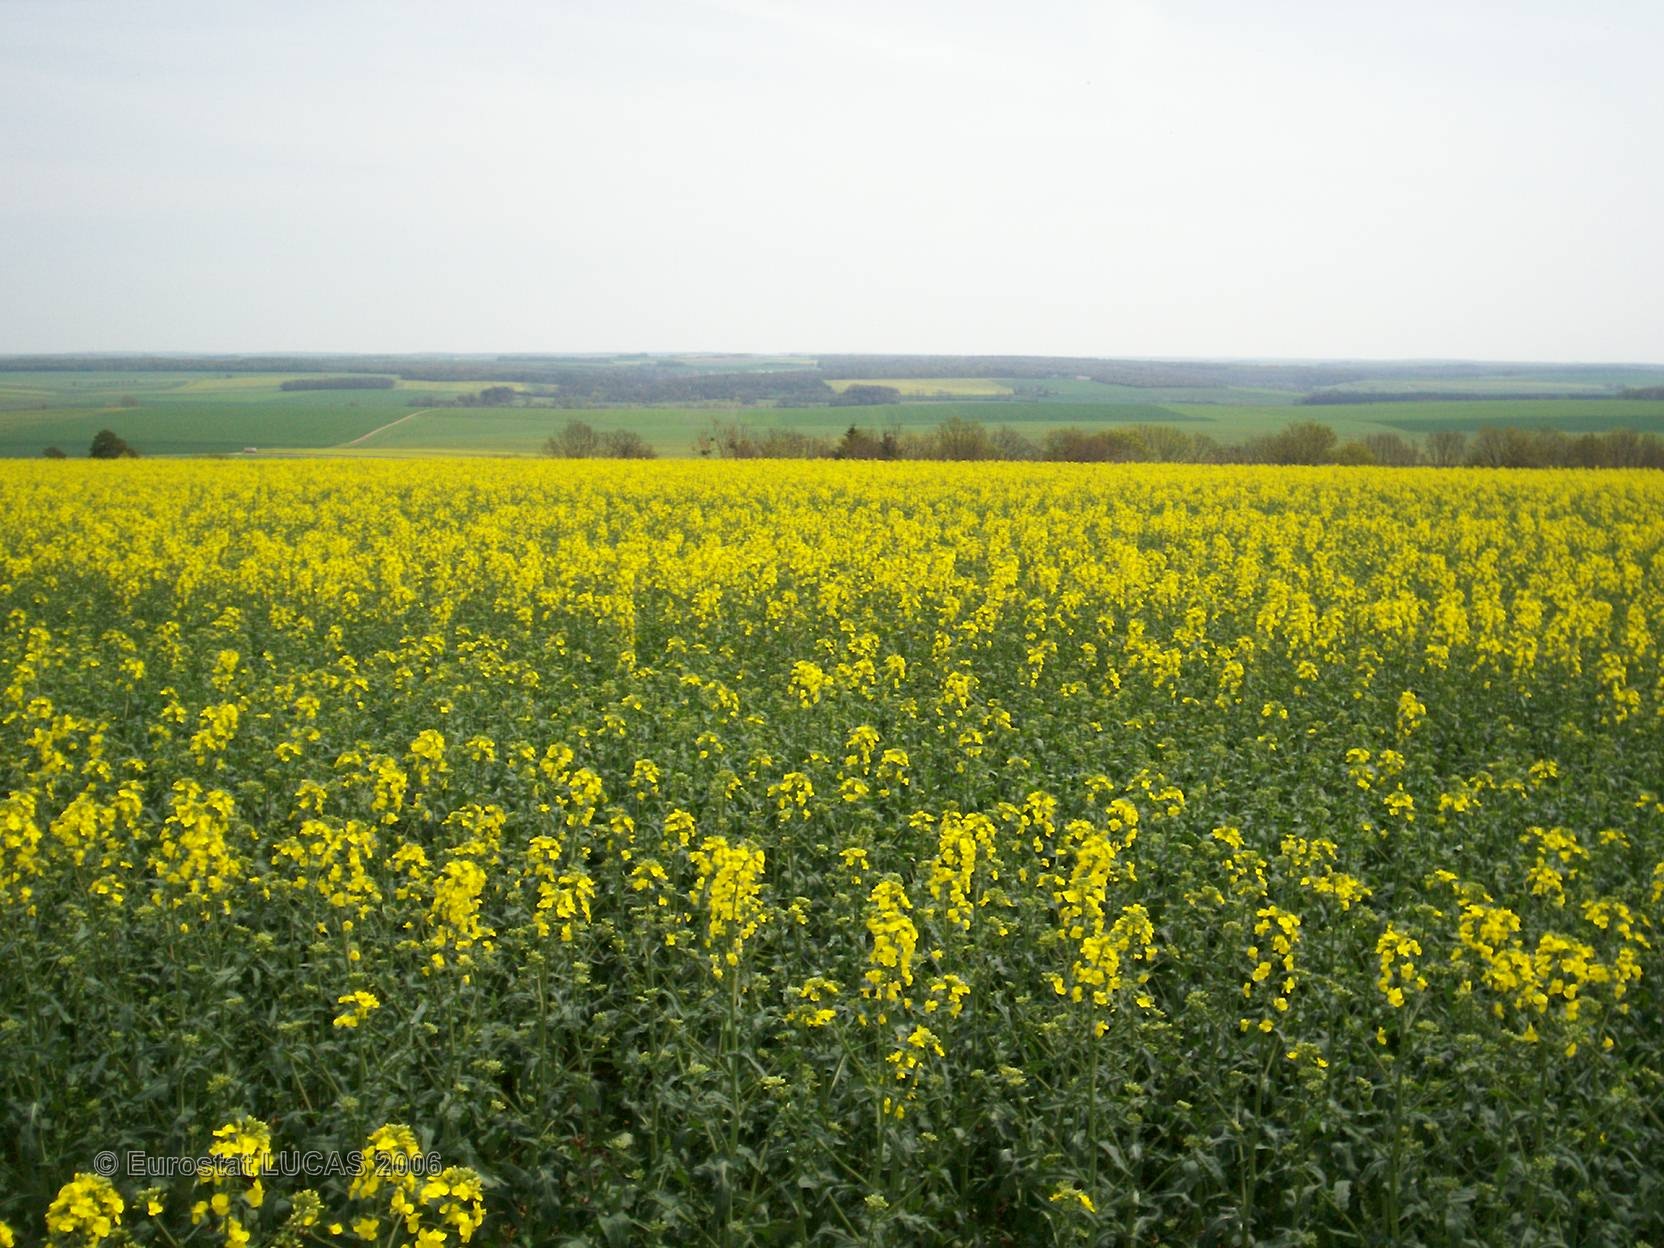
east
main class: Cropland
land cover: Rape and turnip rape
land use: Agriculture (excluding fallow land and kitchen gardens)
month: May
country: FR
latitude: 47.6202
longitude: 4.5570
